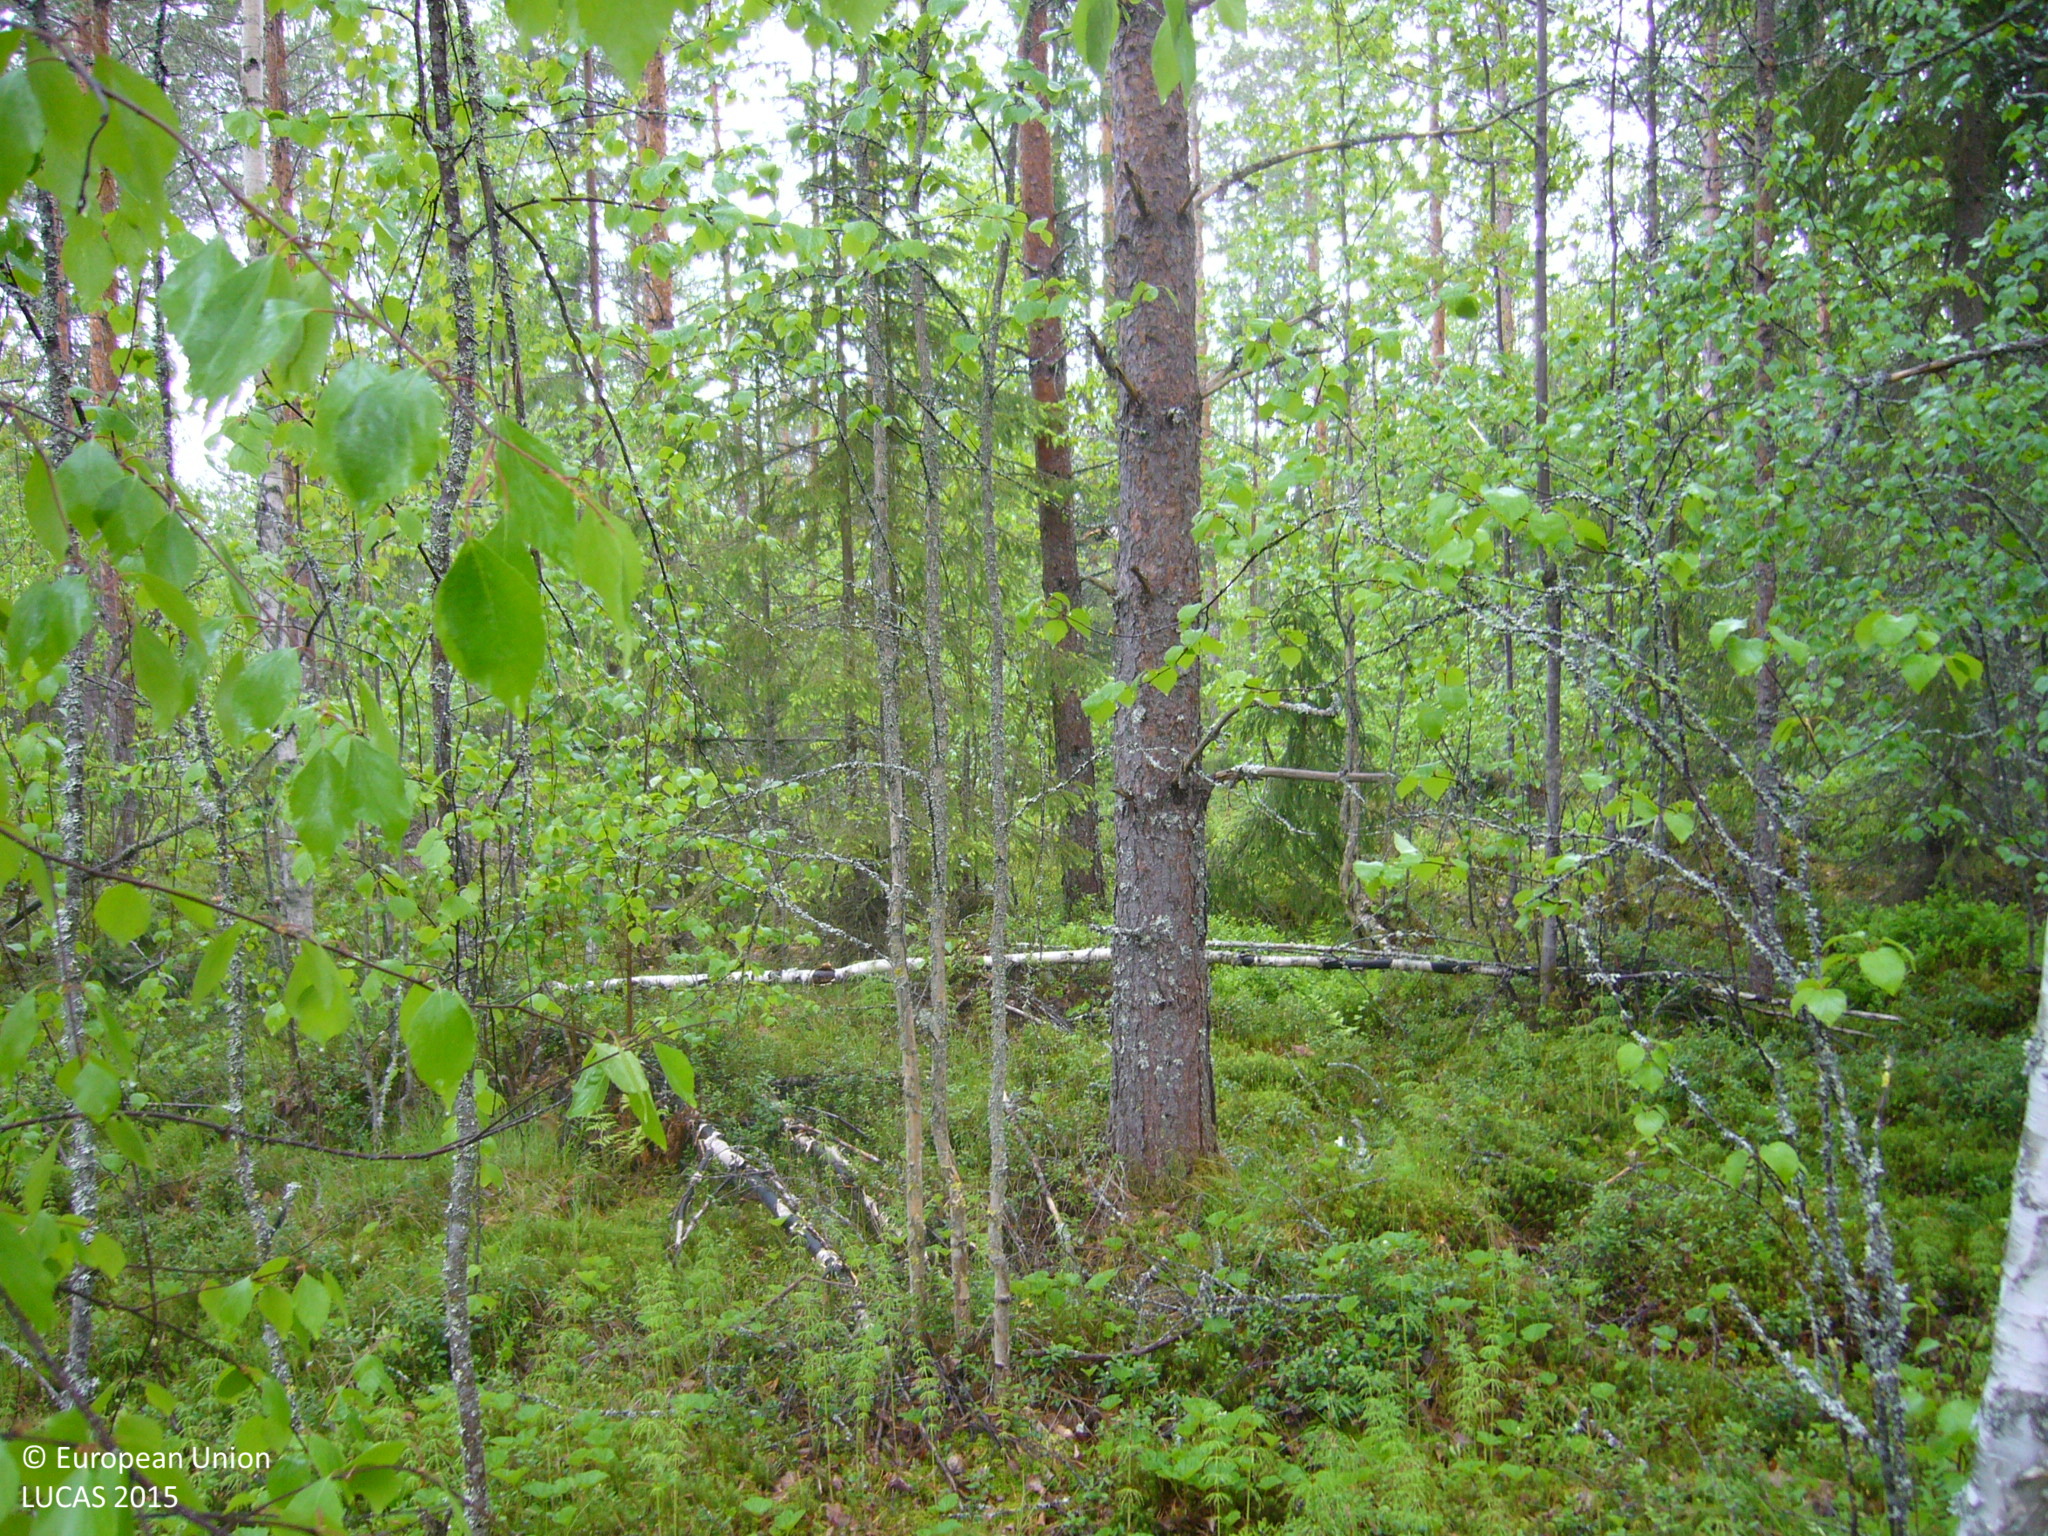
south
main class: Woodland
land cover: Pine dominated mixed woodland
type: boreal forest
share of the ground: 50 - 75 %
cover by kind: broadleaved forest trees 40 %, coniferous forest trees 30 %, shrubs 30 %
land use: Forestry
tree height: > 5 m
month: June
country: FI
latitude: 63.2704
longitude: 26.2851
